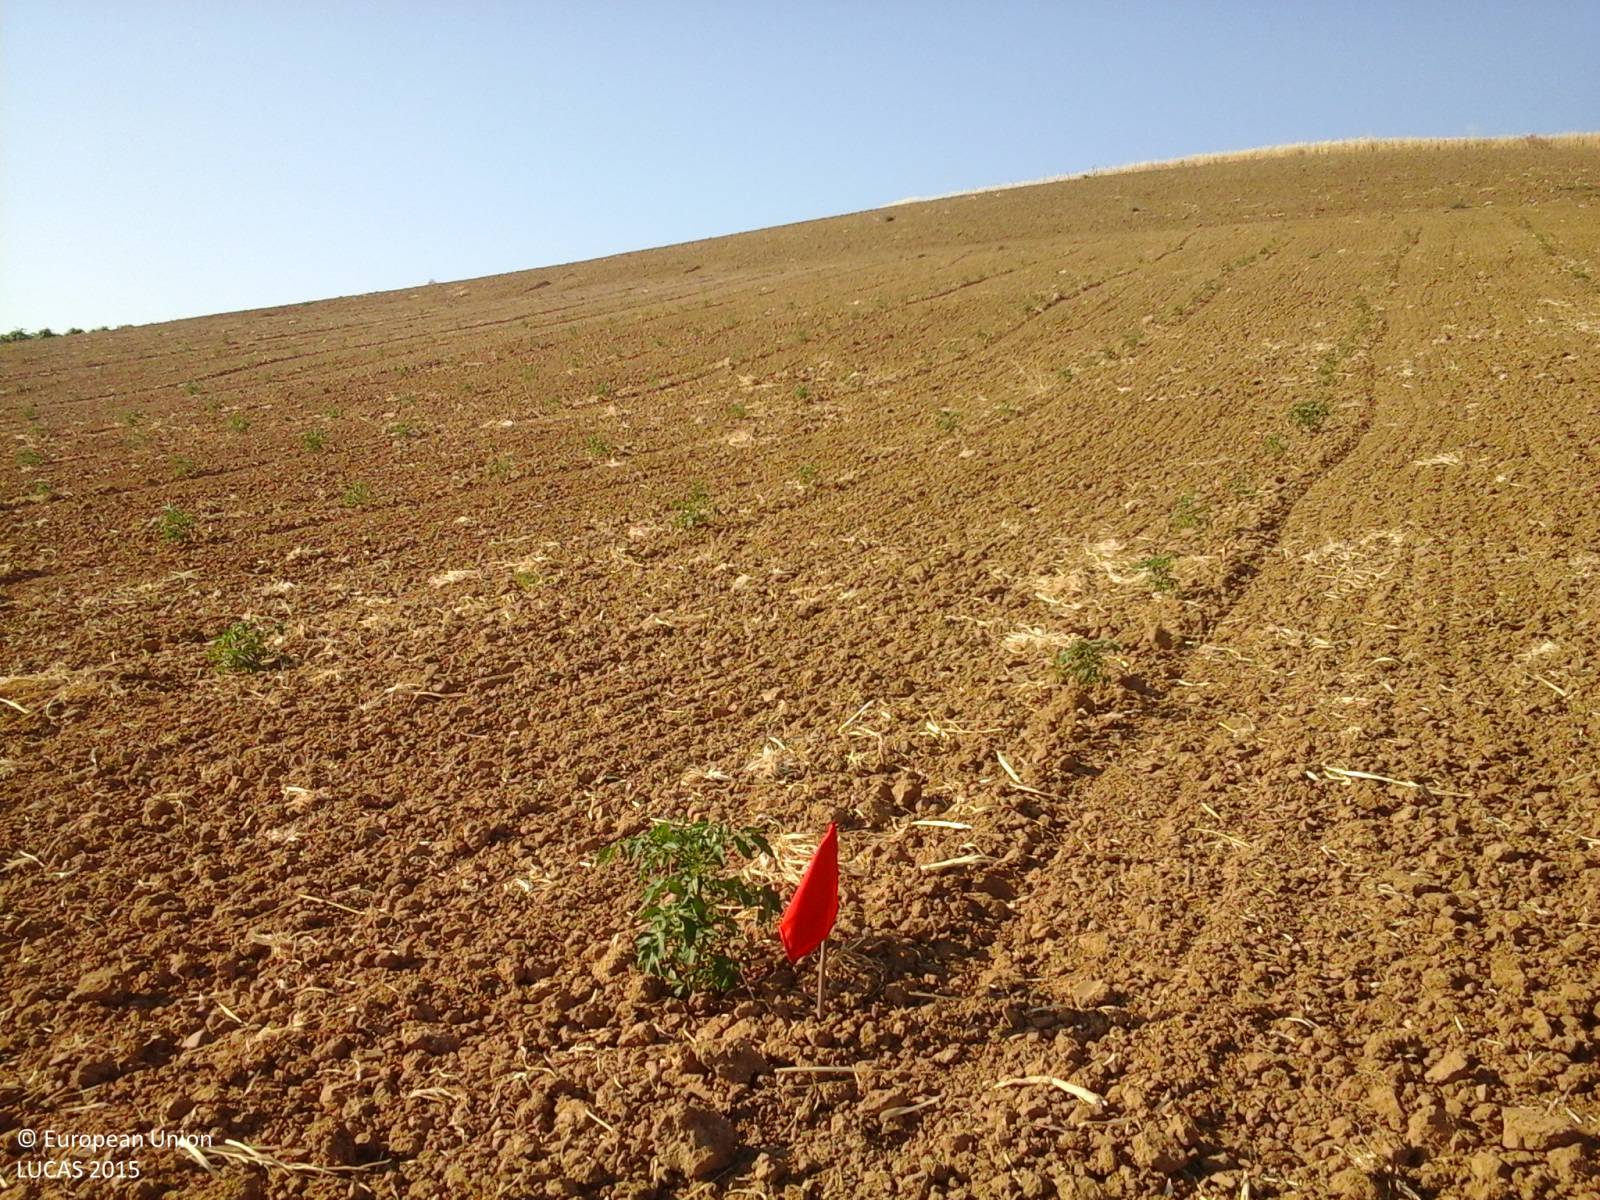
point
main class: Cropland
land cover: Tomatoes
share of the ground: < 10 %
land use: Agriculture (excluding fallow land and kitchen gardens)
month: June
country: IT
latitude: 37.9466
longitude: 12.6548
